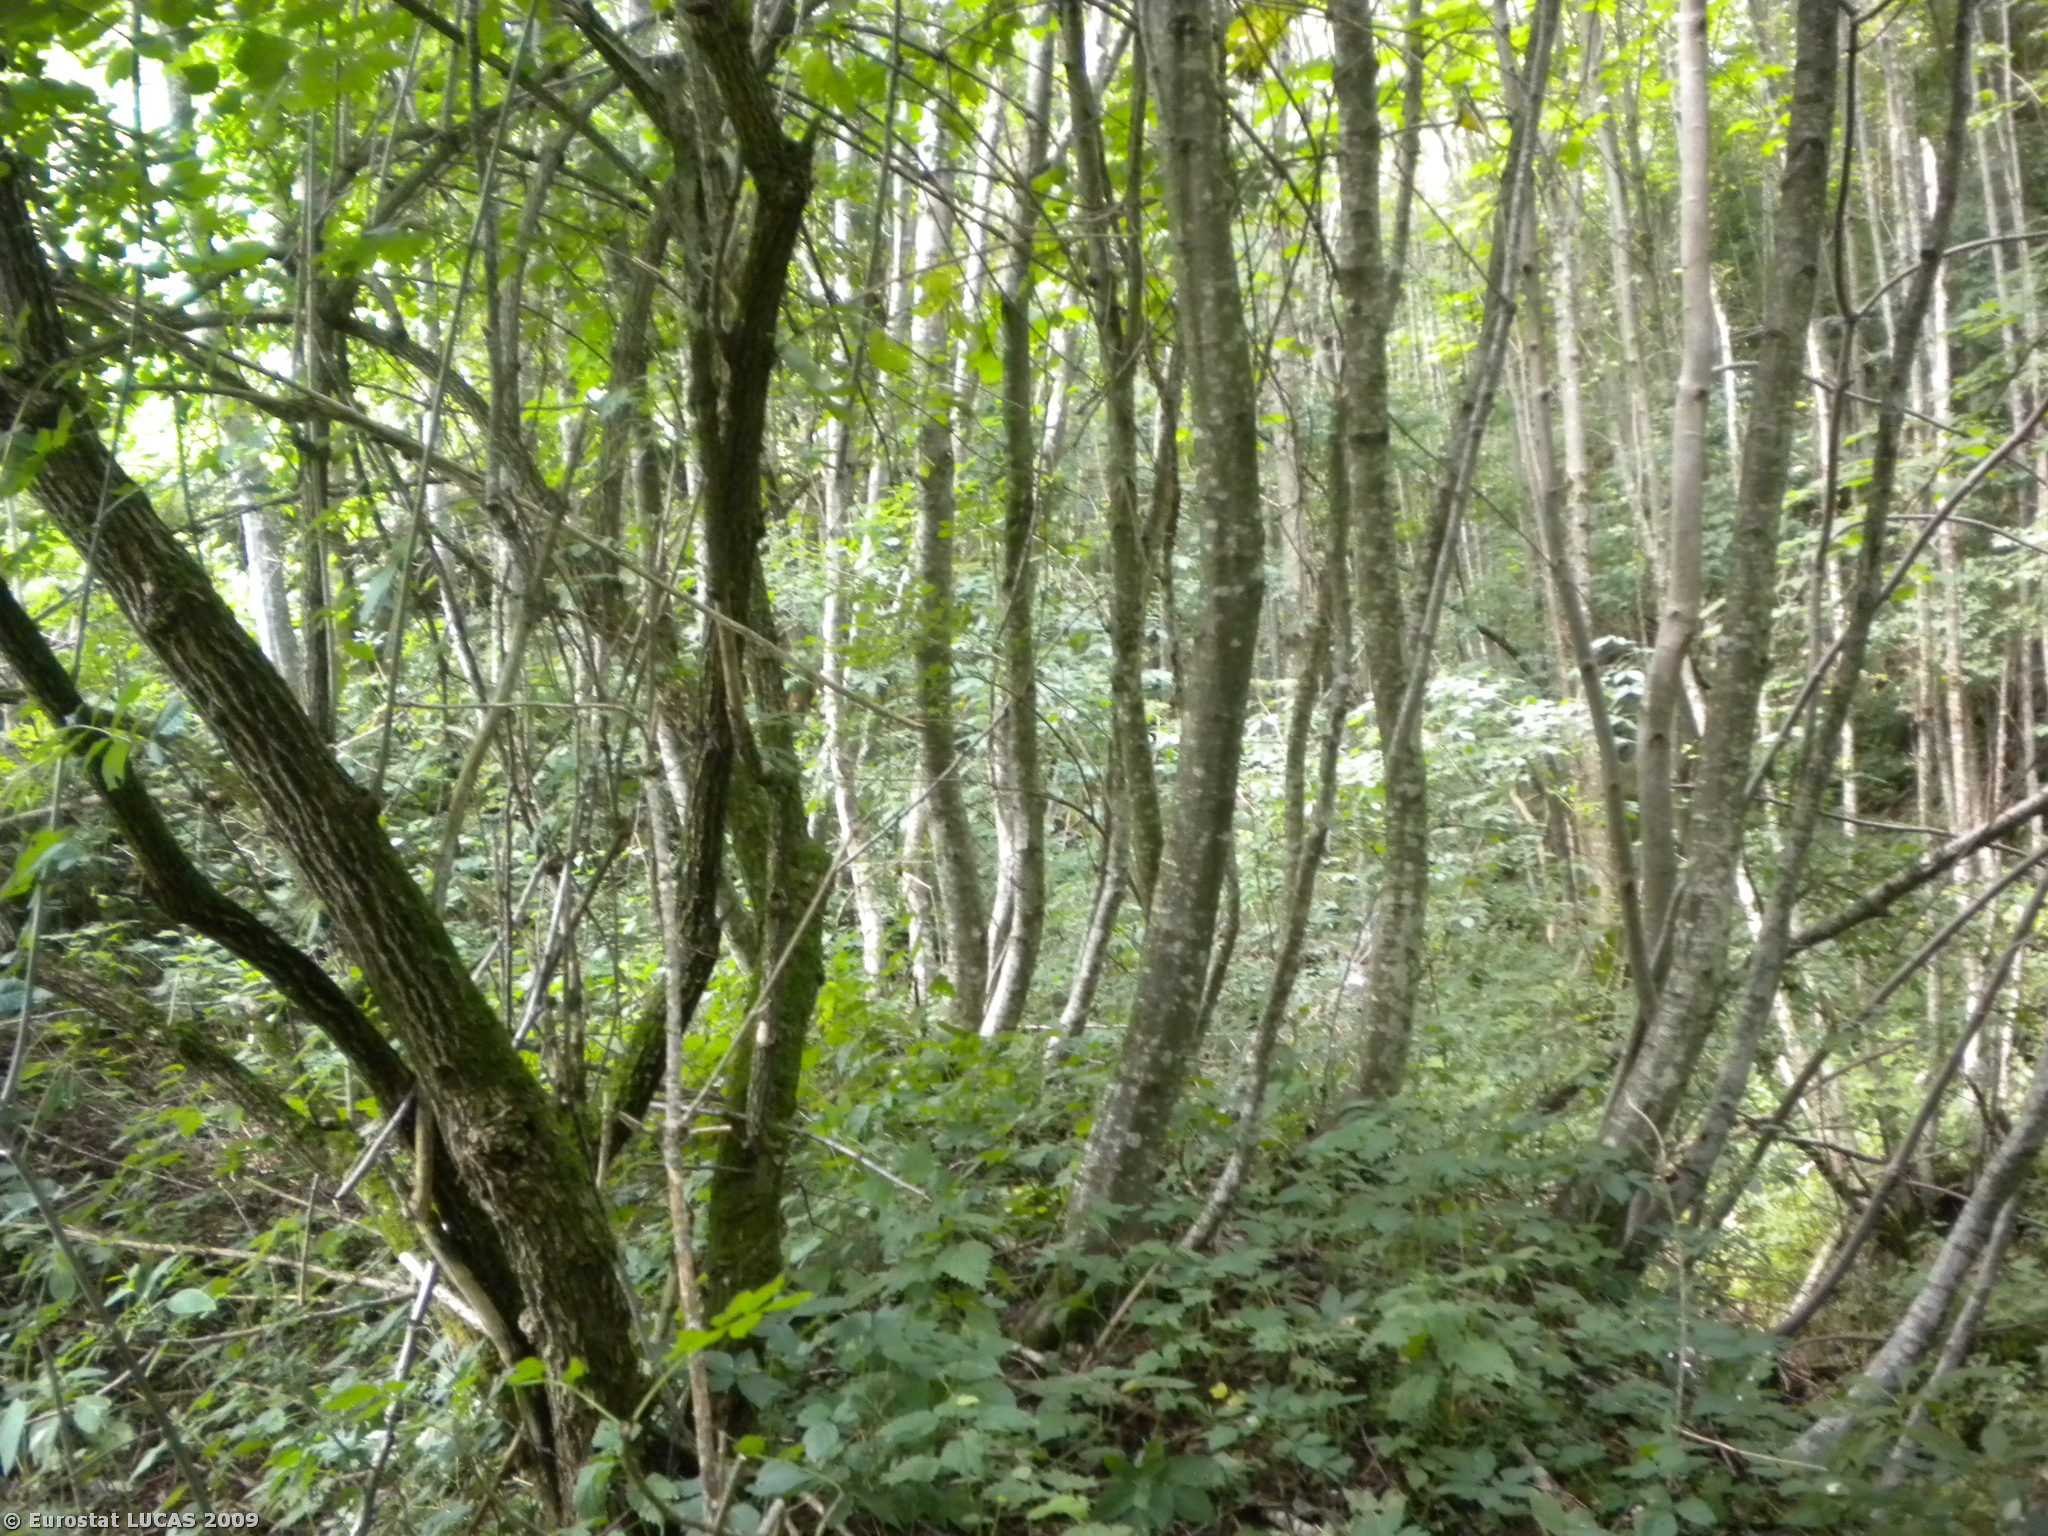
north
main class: Woodland
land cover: Broadleaved woodland
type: beech forest
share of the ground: > 75 %
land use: Forestry
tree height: > 5 m
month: August
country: AT
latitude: 46.8536
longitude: 13.4731
